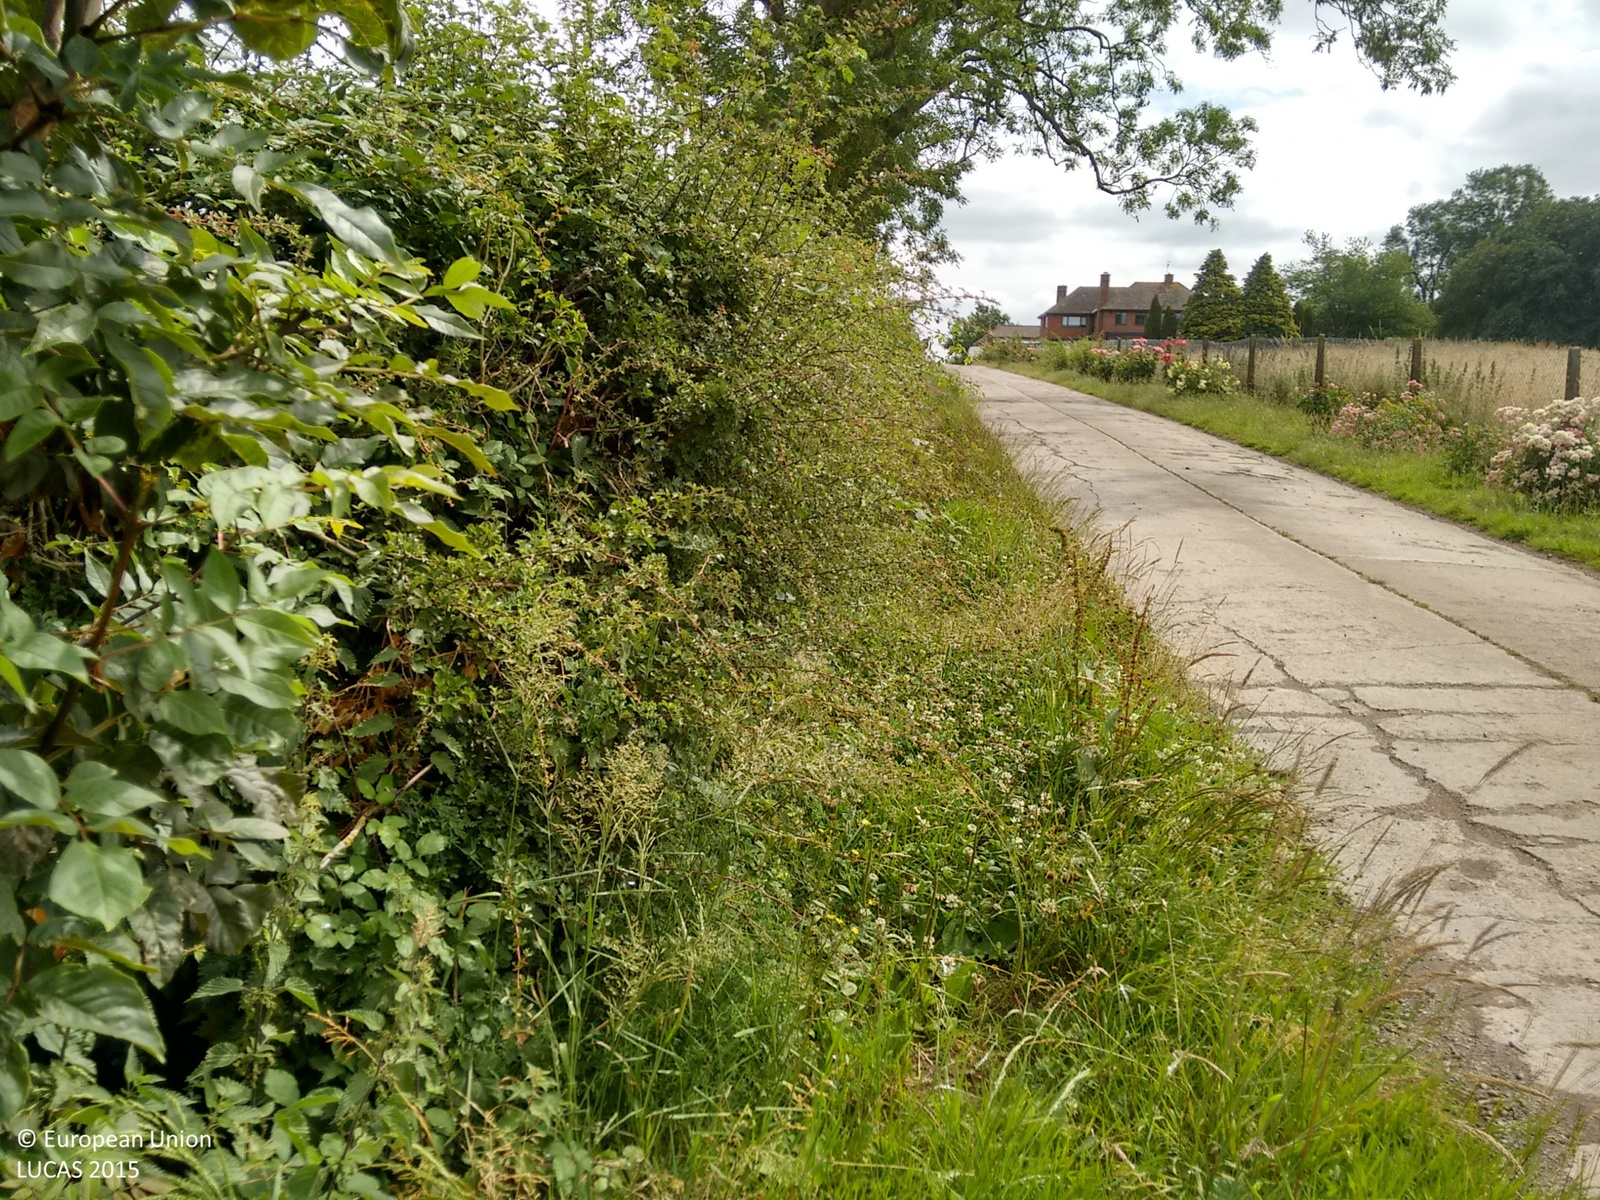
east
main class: Cropland
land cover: Common wheat
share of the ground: > 75 %
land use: Agriculture (excluding fallow land and kitchen gardens)
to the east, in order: Common wheat; Other bare soil; Paved roads, cycling and walking lanes; Other bare soil; Artificial constructions in urban areas
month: July
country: GB
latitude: 52.1292
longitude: -2.5275
